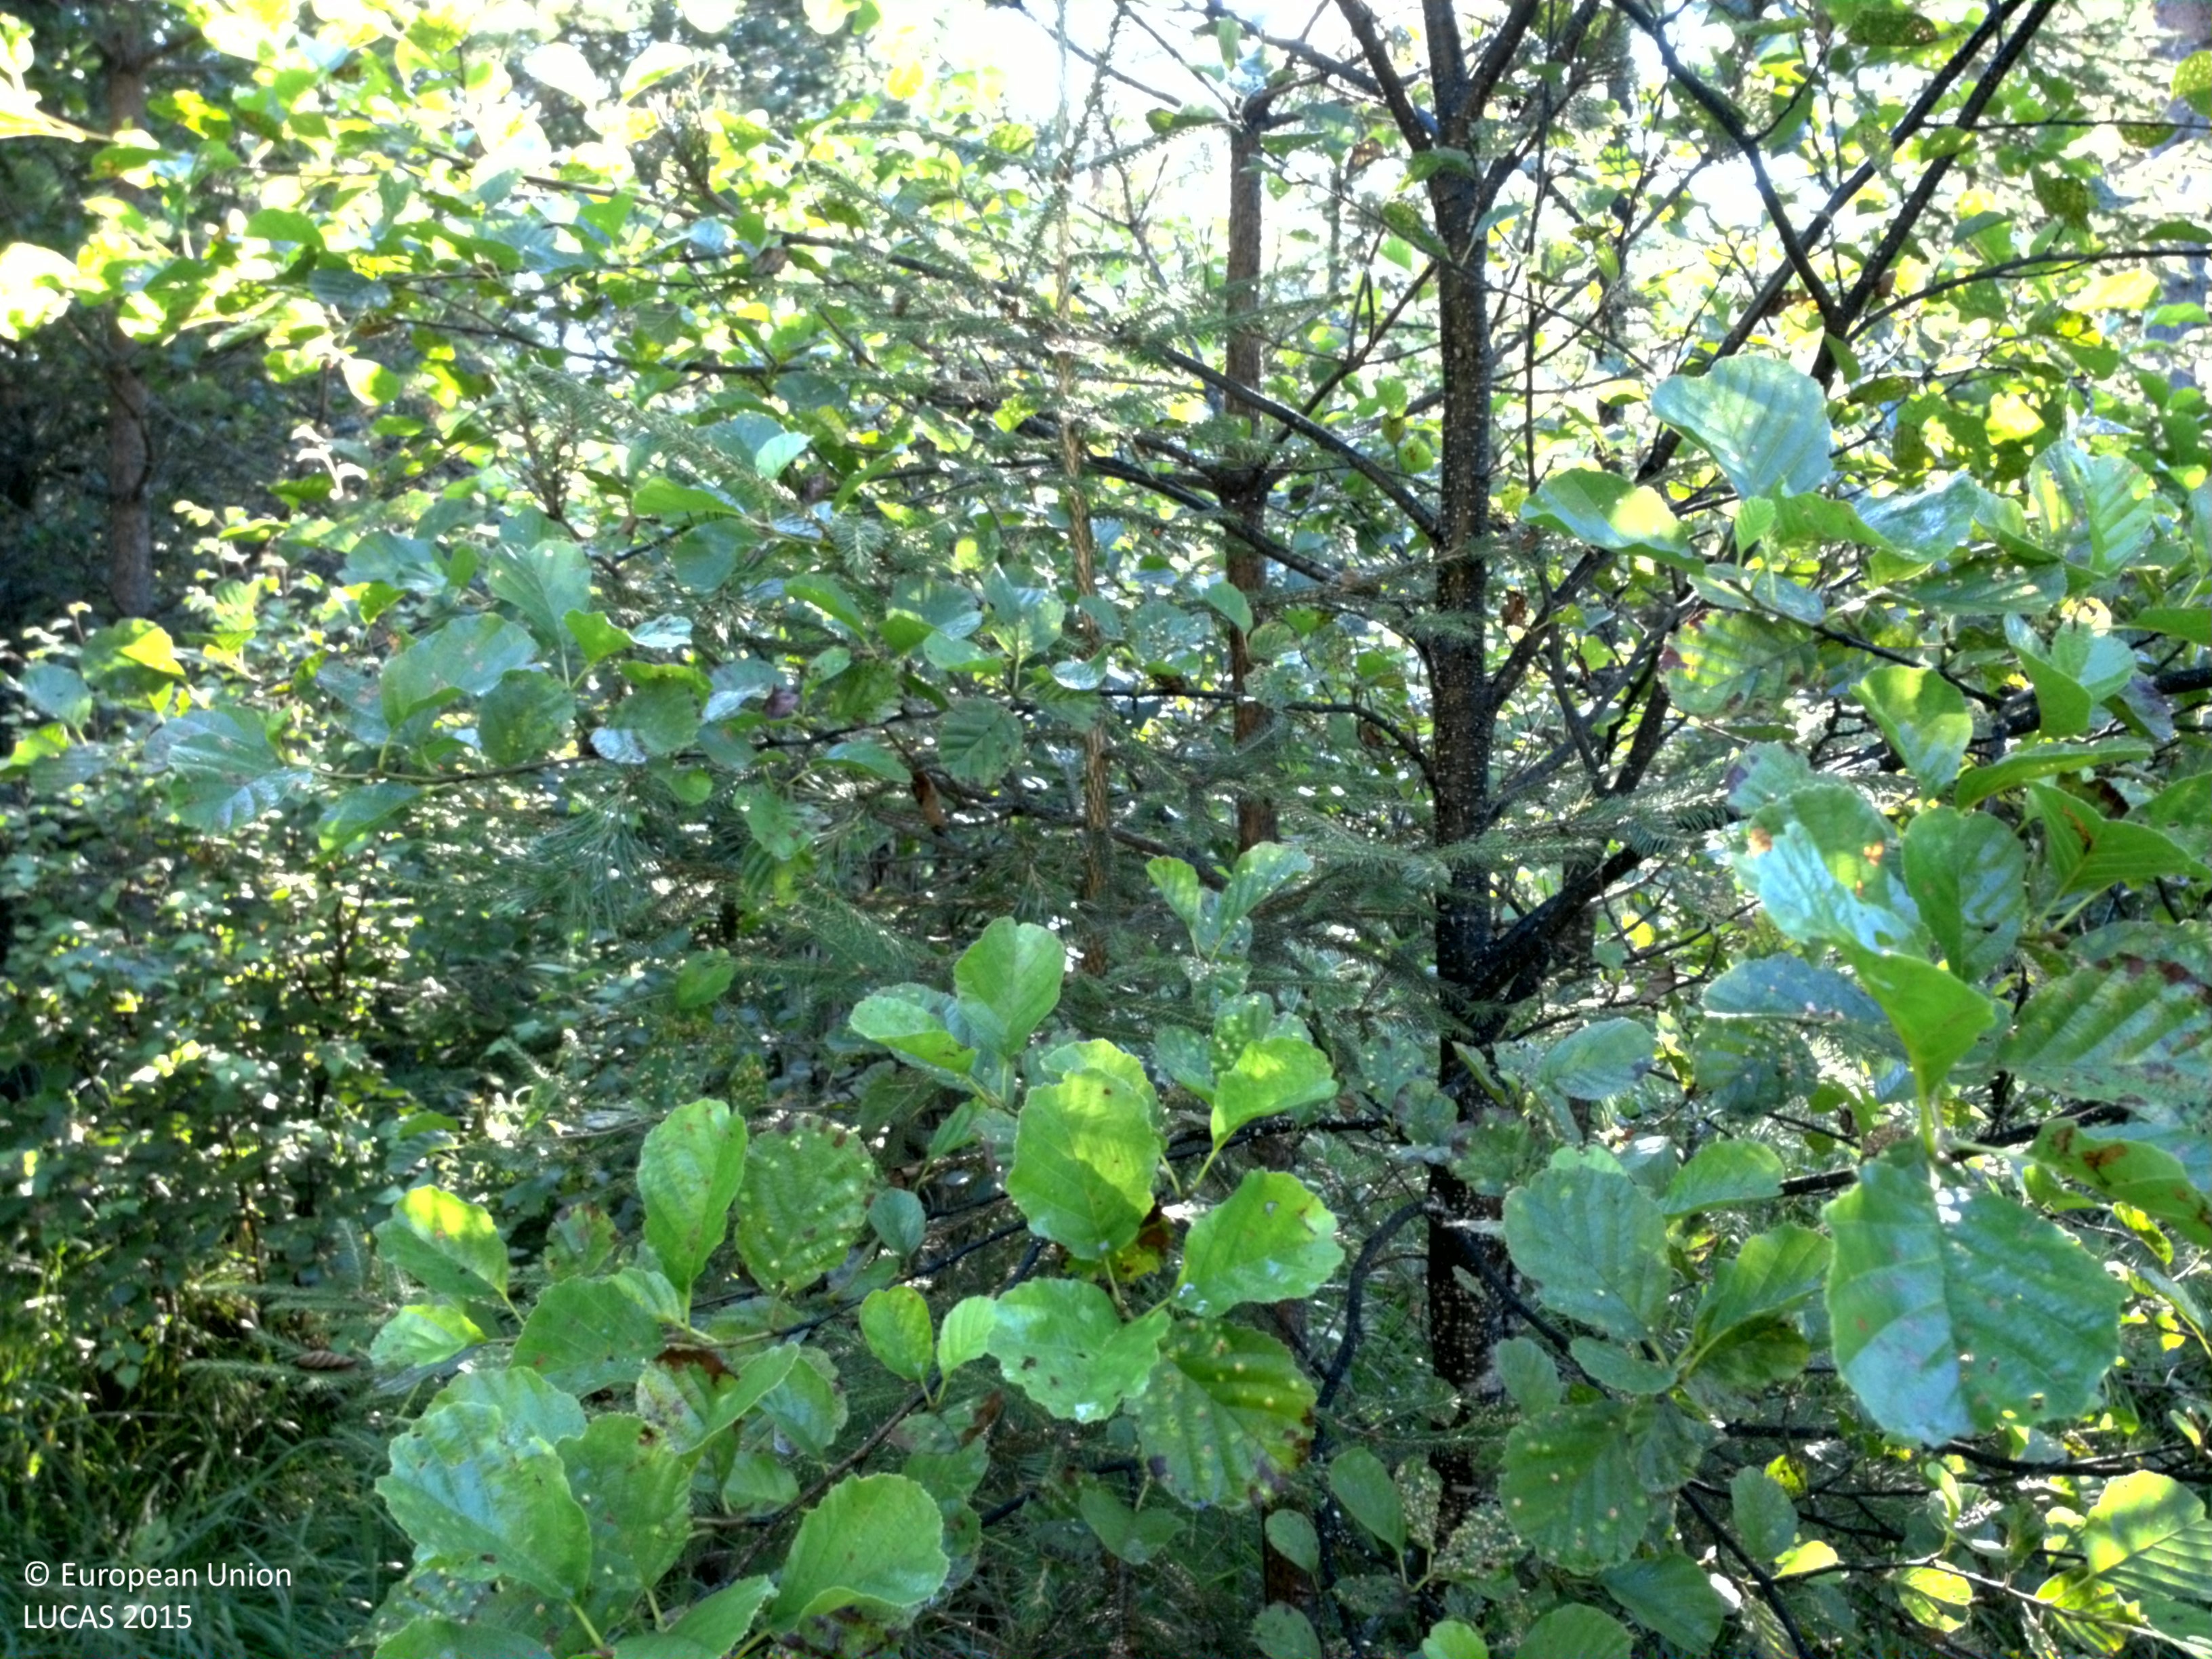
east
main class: Woodland
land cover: Broadleaved woodland
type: mire and swamp forests
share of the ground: 25 - 50 %
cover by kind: broadleaved forest trees 40 %, herbaceous plants 40 %, shrubs 10 %, coniferous forest trees 5 %, lichens and mosses 5 %
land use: Forestry
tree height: > 5 m
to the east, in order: Broadleaved woodland; Pine dominated mixed woodland; Shrubland with sparse tree cover; Paved roads, cycling and walking lanes; Shrubland with sparse tree cover; Ditches and canals; Pine dominated mixed woodland; Tracks; Pine dominated coniferous woodland; Tracks; Pine dominated coniferous woodland; Spruce dominated coniferous woodland
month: August
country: SE
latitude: 60.2117
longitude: 13.4011
